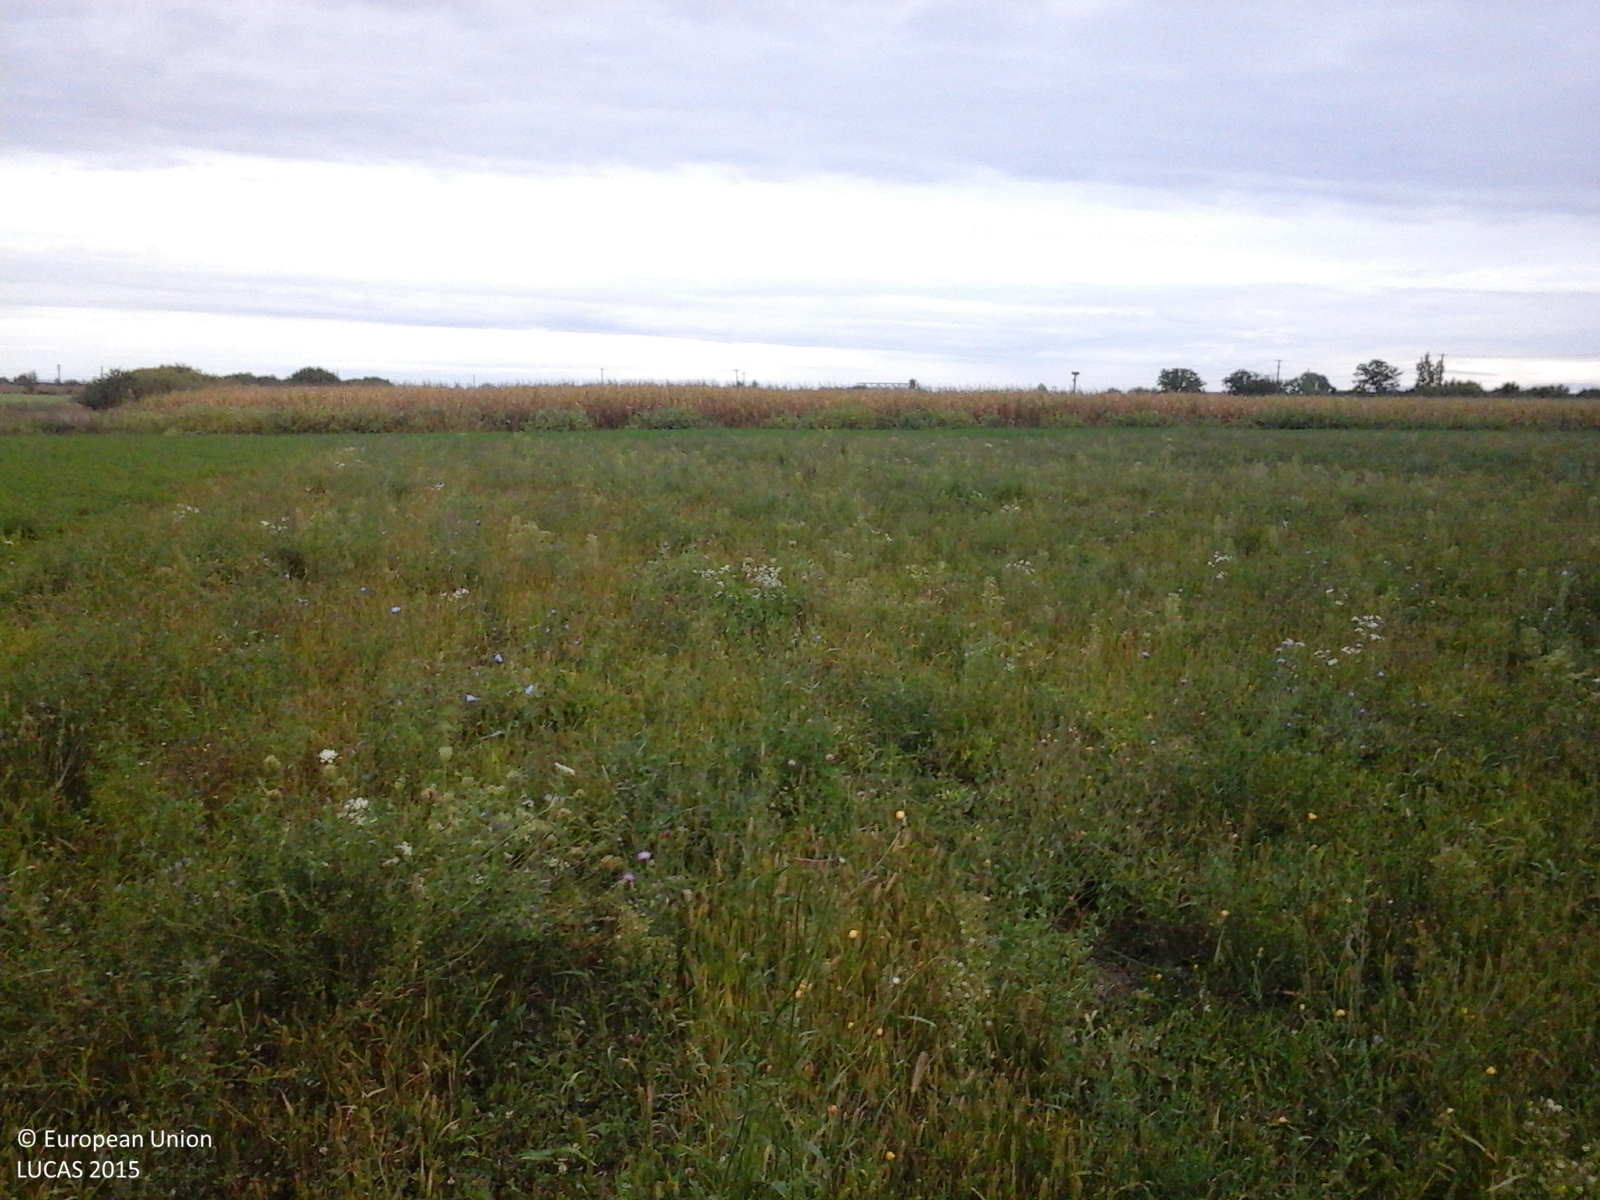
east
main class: Grassland
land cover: Spontaneously vegetated surfaces
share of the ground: > 75 %
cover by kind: herbaceous plants 100 %
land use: Fallow land
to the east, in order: Spontaneously vegetated surfaces; Lucerne; Shruby margins; Maize
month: September
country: RO
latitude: 46.7963
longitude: 21.7156
